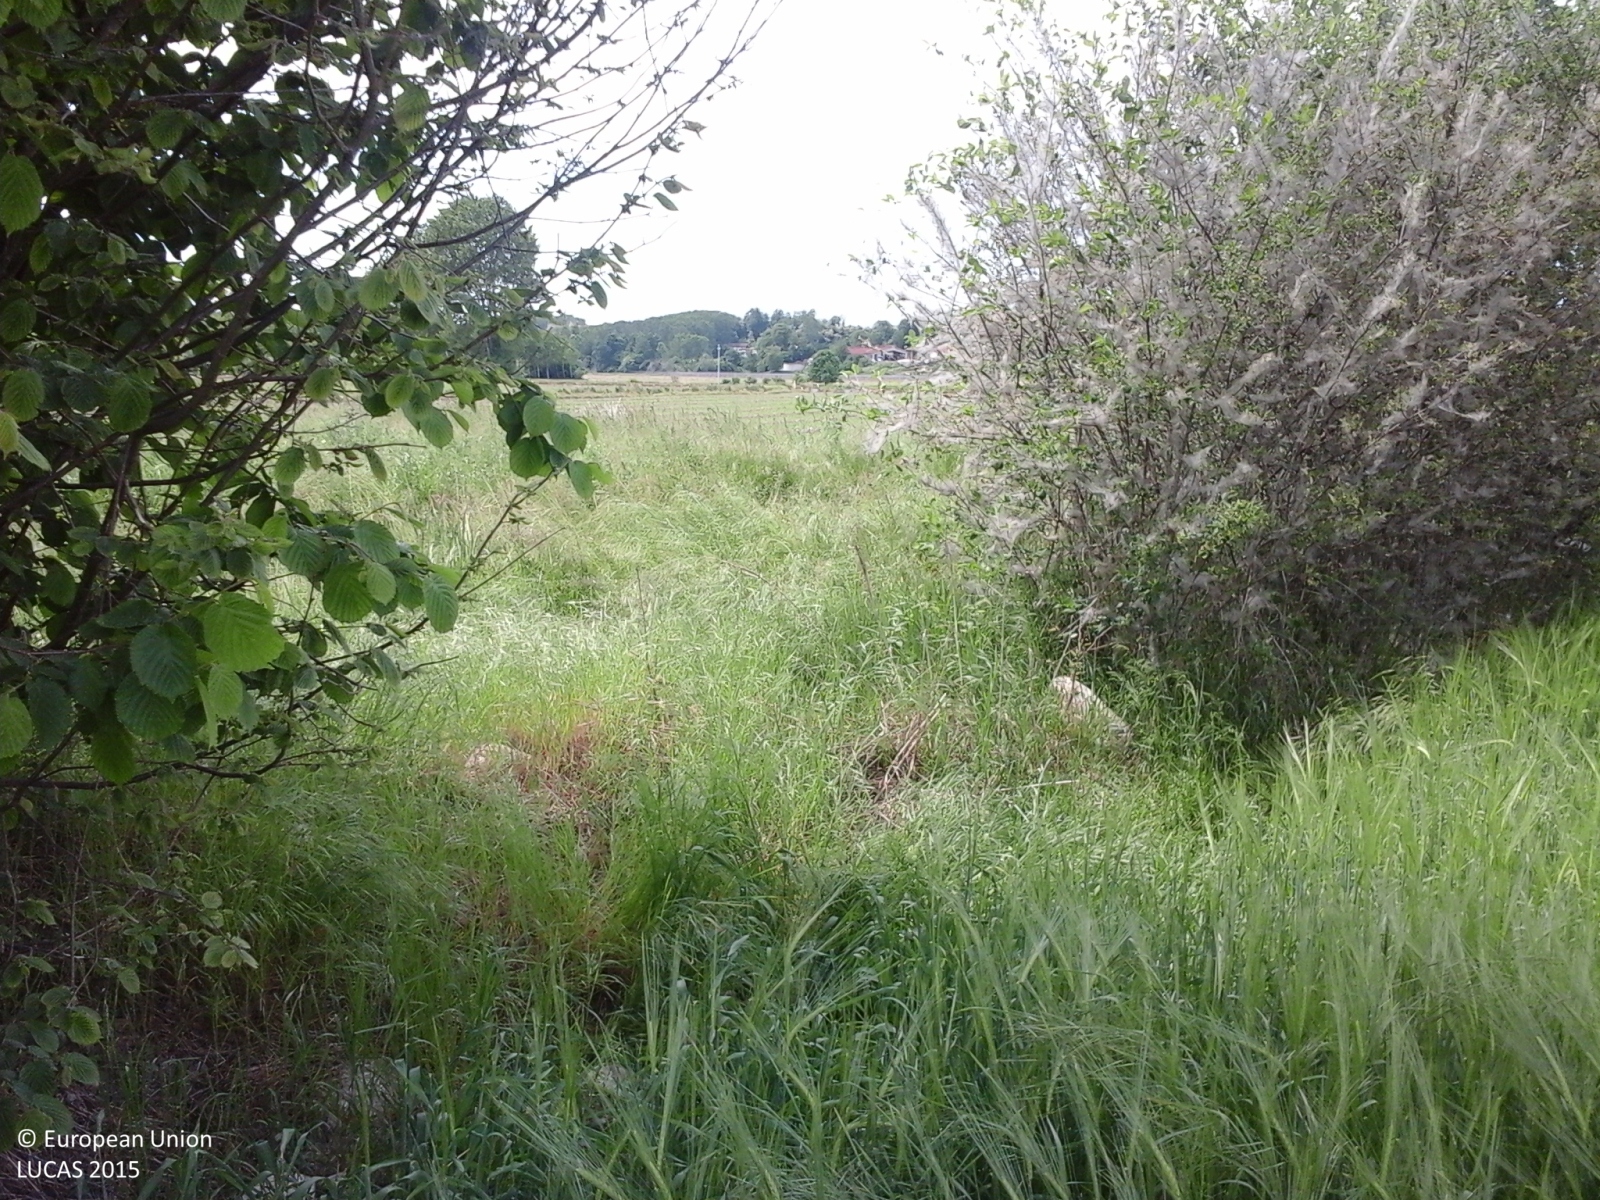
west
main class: Cropland
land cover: Barley
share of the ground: > 75 %
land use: Agriculture (excluding fallow land and kitchen gardens)
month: May
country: IT
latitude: 44.4870
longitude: 7.6786
